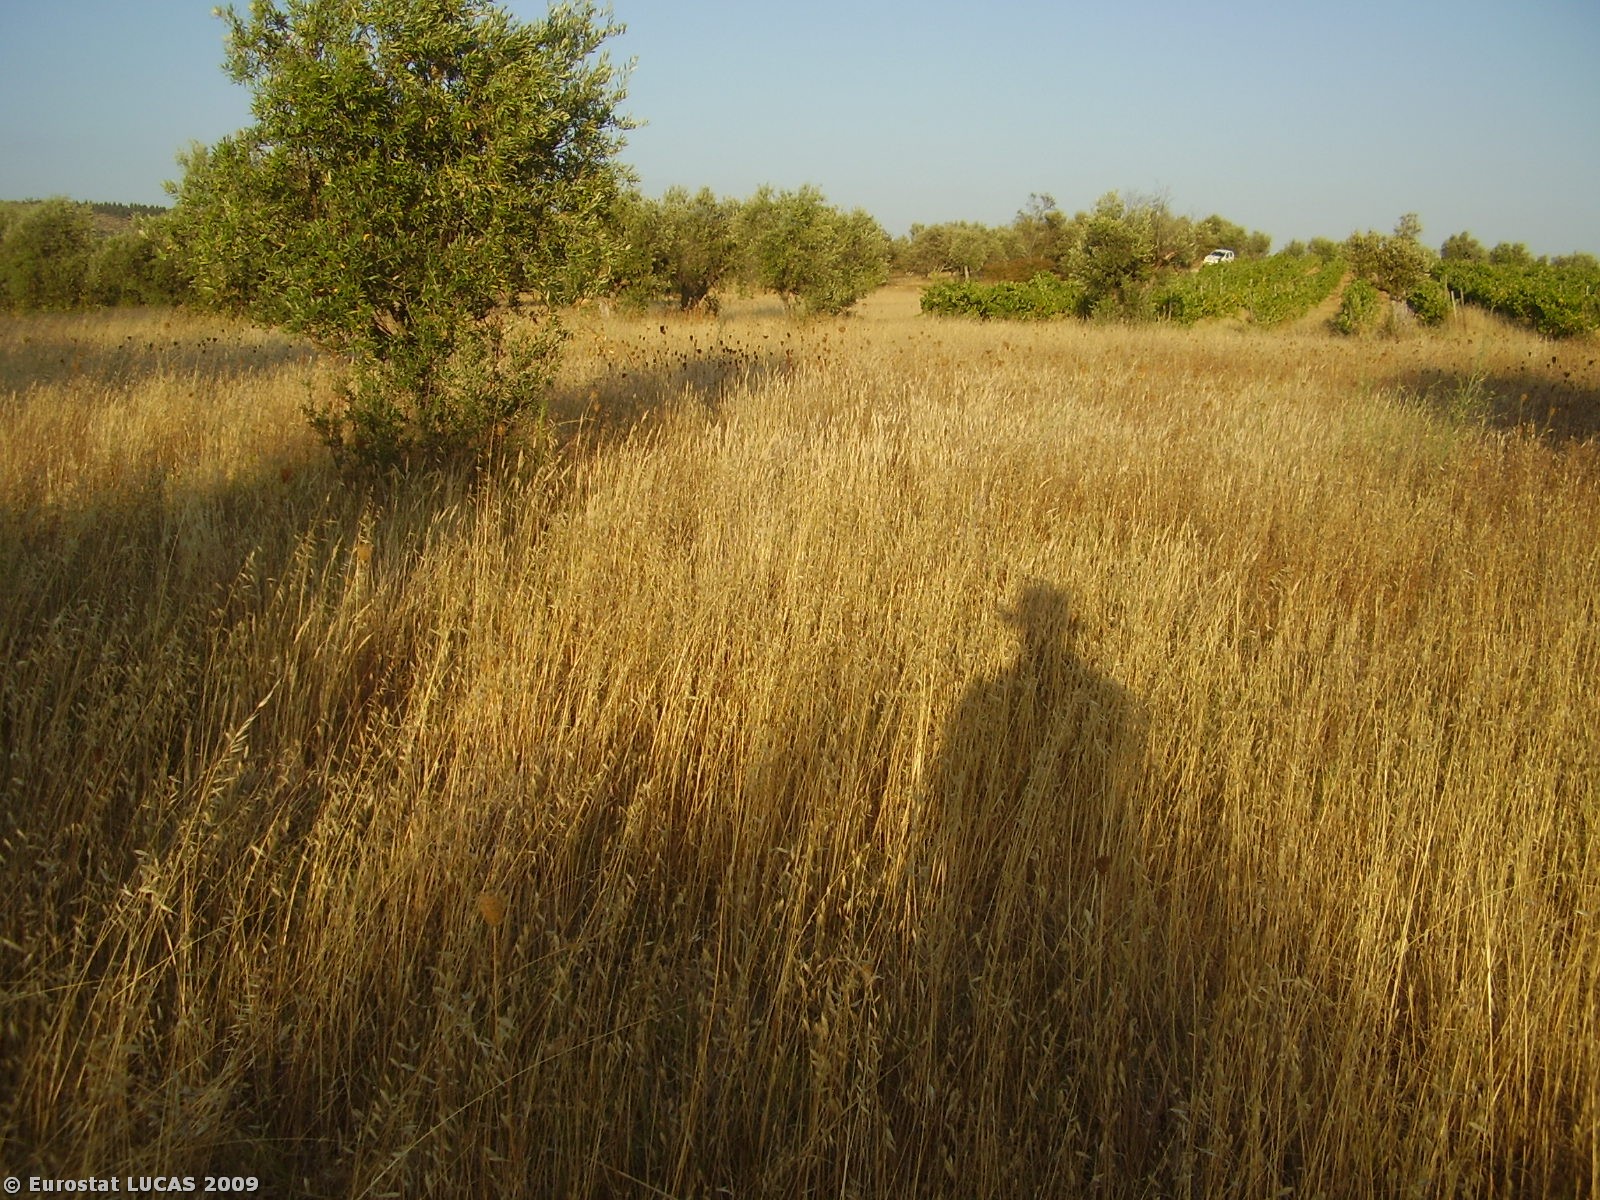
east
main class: Cropland
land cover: Olive groves
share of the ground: 10 - 25 %
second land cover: Spontaneously vegetated surfaces
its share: > 75 %
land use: Agriculture (excluding fallow land and kitchen gardens)
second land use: Fallow land
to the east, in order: Olive groves; Spontaneously vegetated surfaces; Olive groves; Tracks; Vineyards
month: August
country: PT
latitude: 38.2063
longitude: -7.7645
